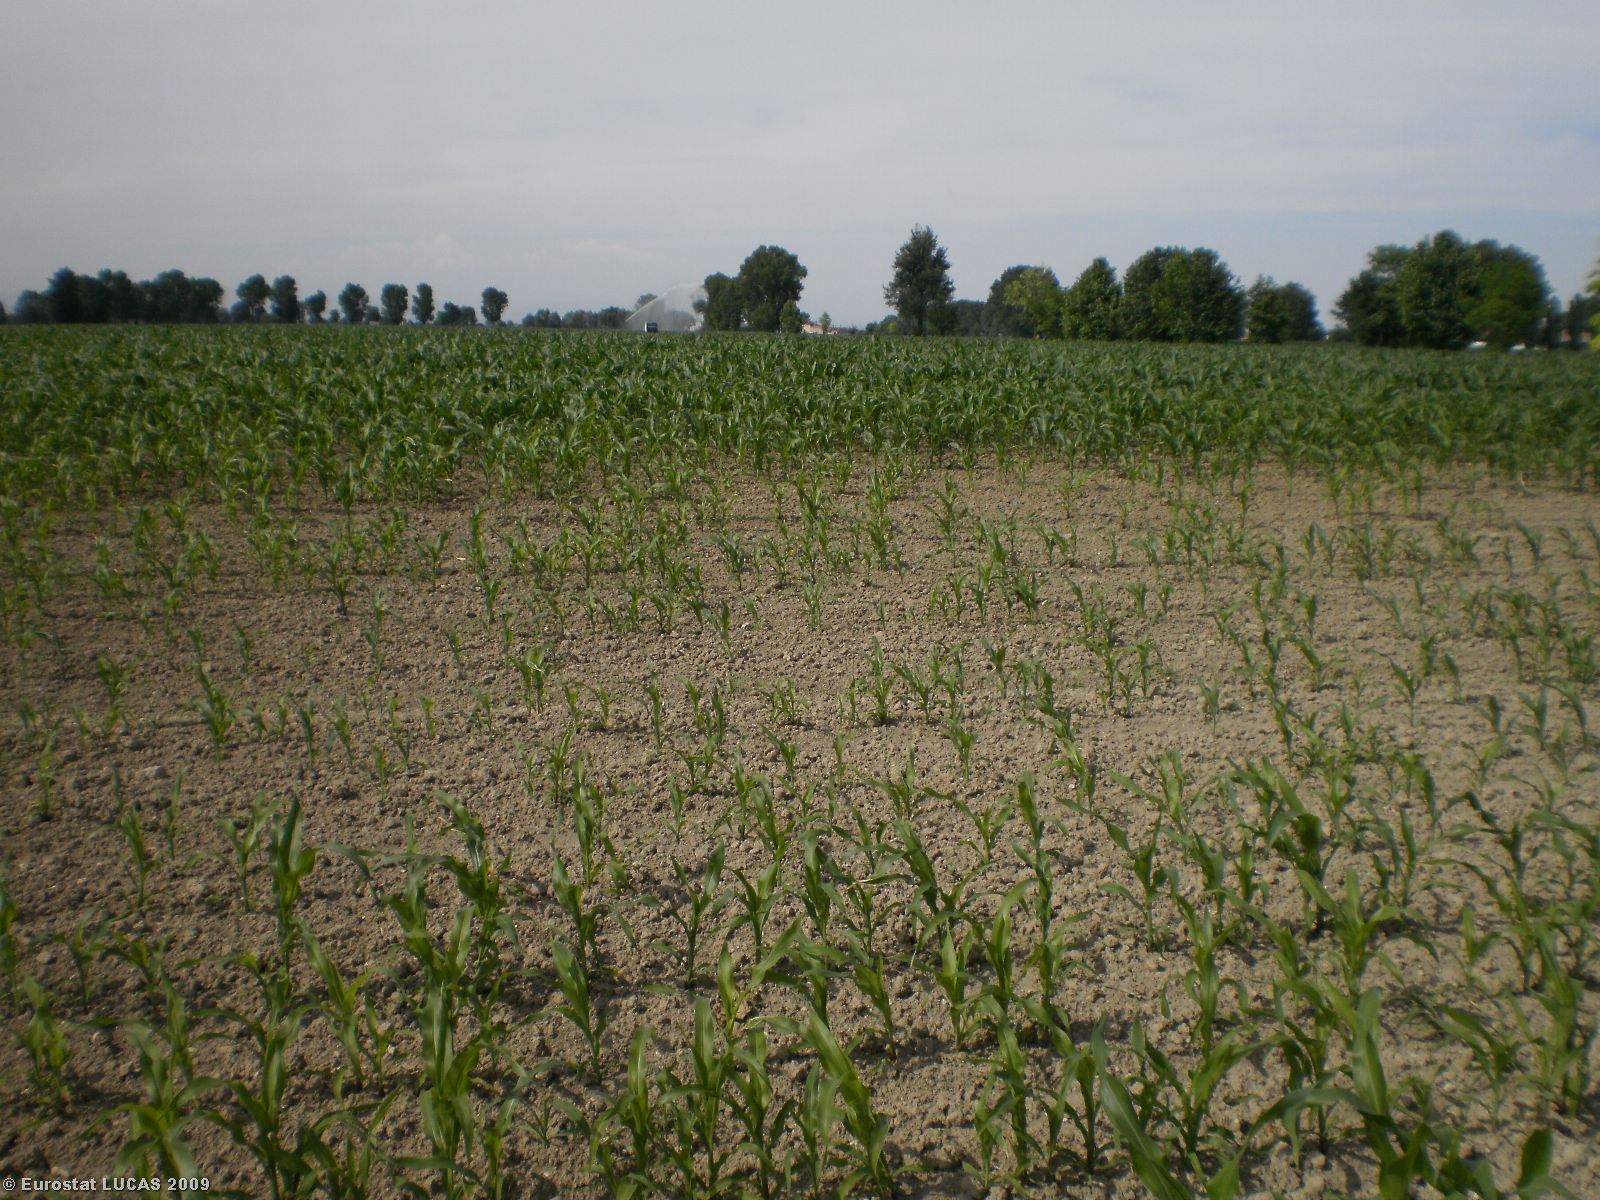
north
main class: Cropland
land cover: Maize
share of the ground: 50 - 75 %
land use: Agriculture (excluding fallow land and kitchen gardens)
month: May
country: IT
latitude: 45.2331
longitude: 10.4450
